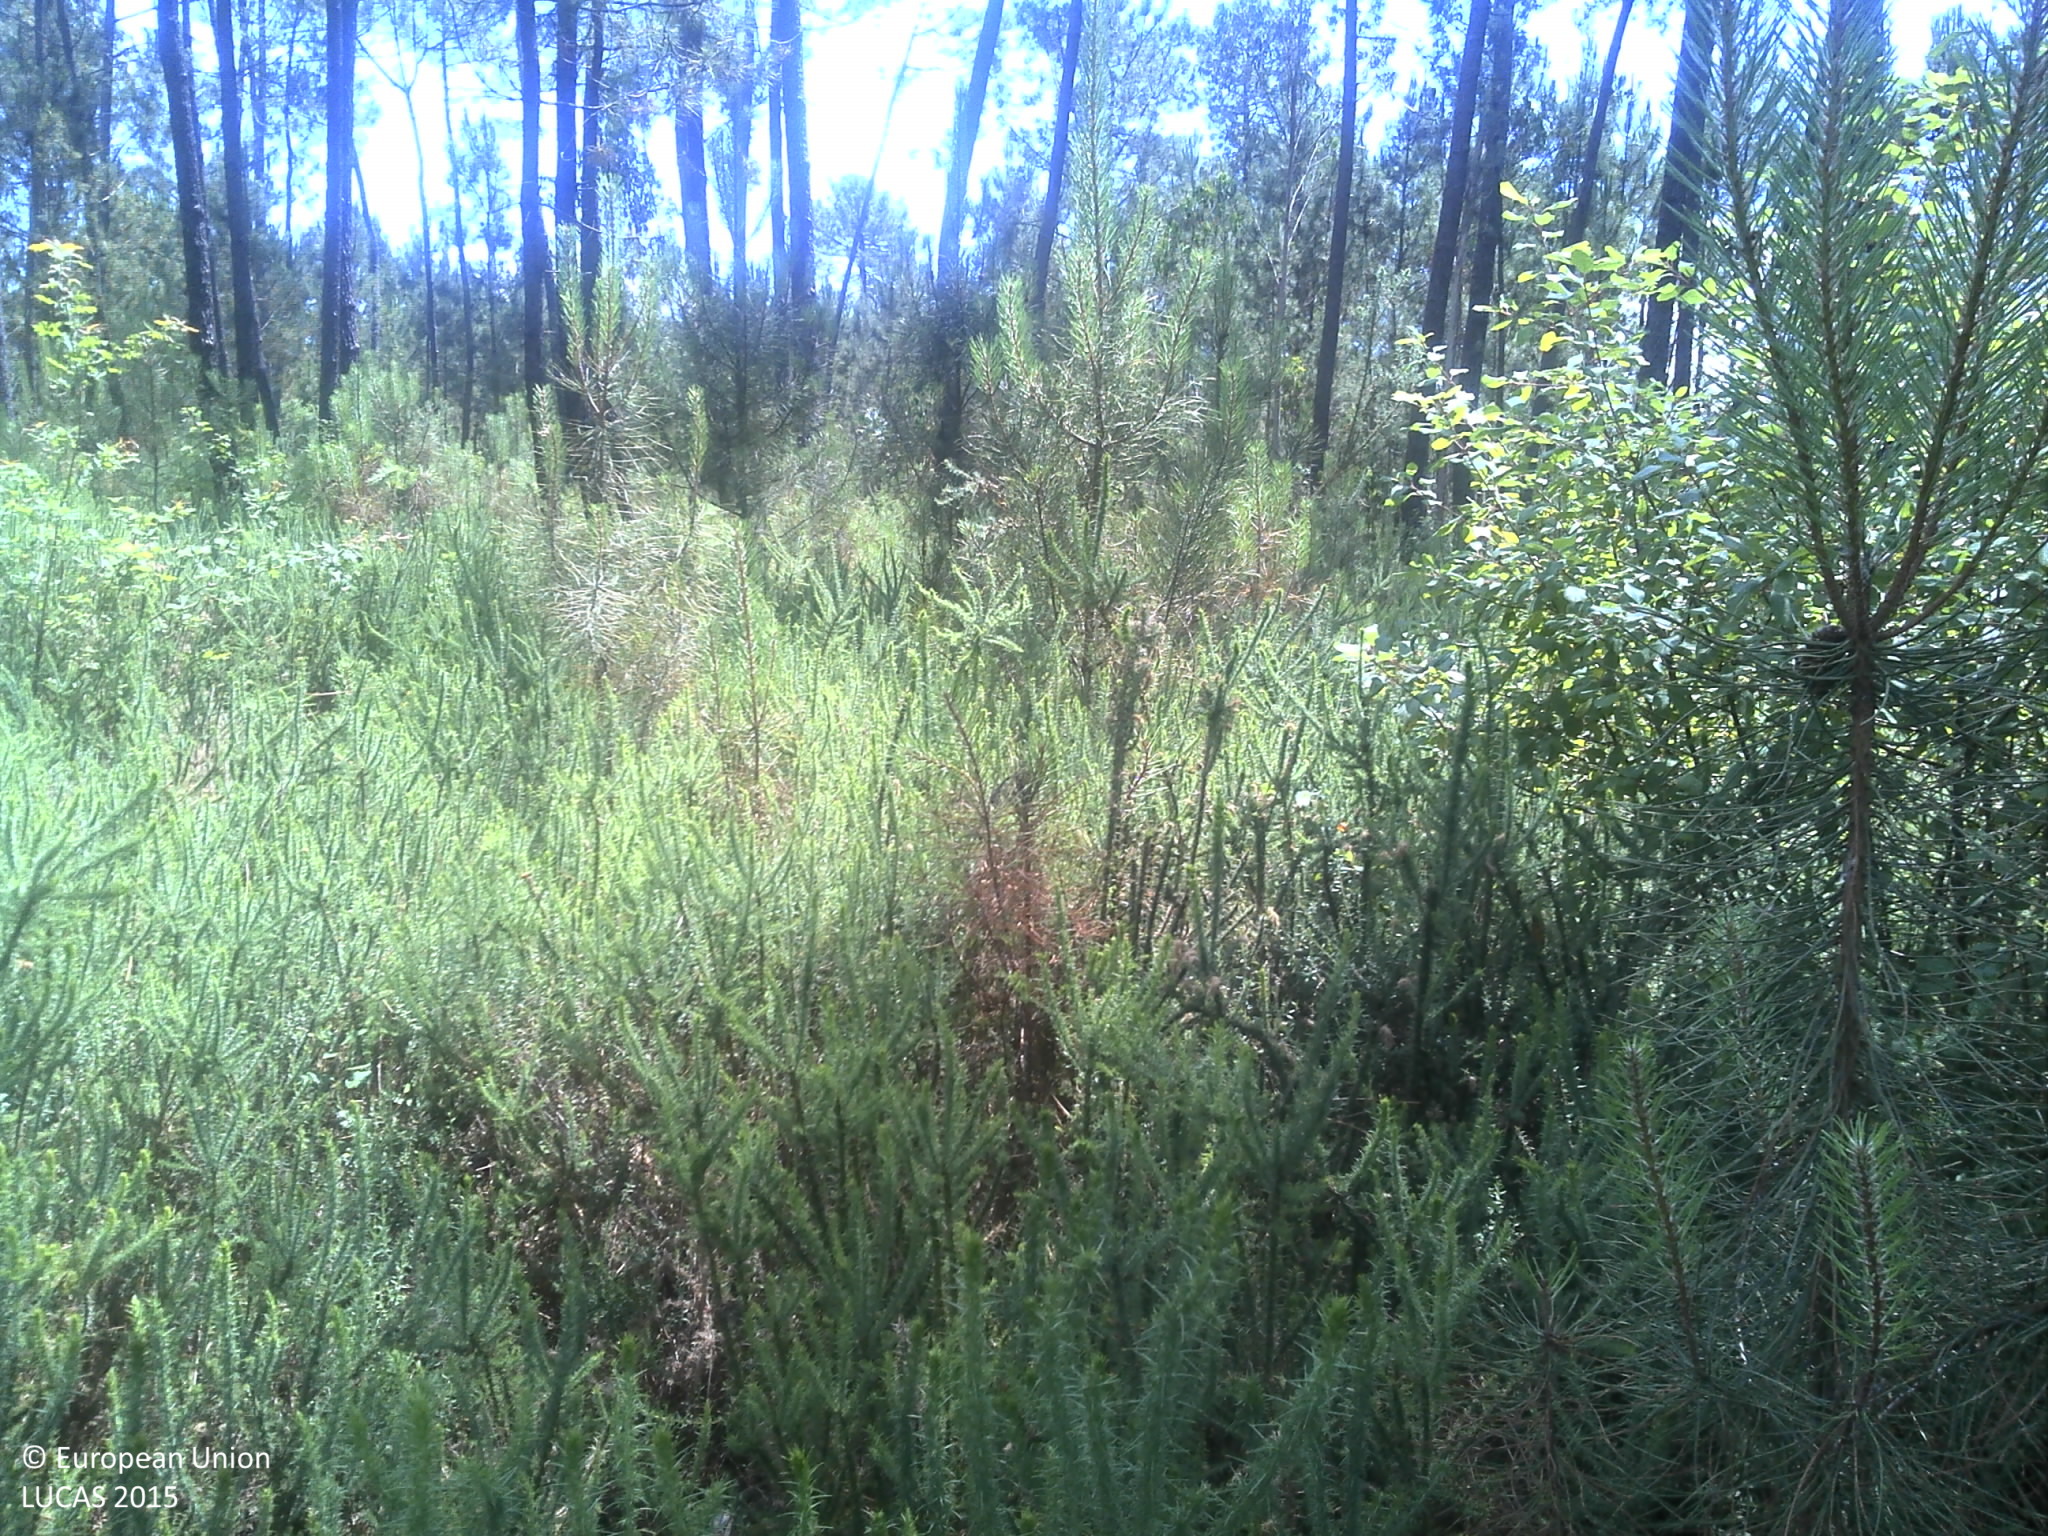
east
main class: Woodland
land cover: Pine dominated coniferous woodland
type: coniferous forest of the mediterranean region
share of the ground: 50 - 75 %
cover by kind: coniferous forest trees 70 %, shrubs 25 %, broadleaved forest trees 5 %
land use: Forestry
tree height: > 5 m
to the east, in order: Pine dominated coniferous woodland; Tracks; Pine dominated coniferous woodland; Paved roads, cycling and walking lanes; Pine dominated mixed woodland; Artificial constructions; Shrubland without tree cover; Fences; Paved roads, cycling and walking lanes; Fences; Shrubland without tree cover; Paved roads, cycling and walking lanes; Pine dominated mixed woodland; Shrubland without tree cover; Tracks
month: June
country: PT
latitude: 41.6234
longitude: -8.5585
